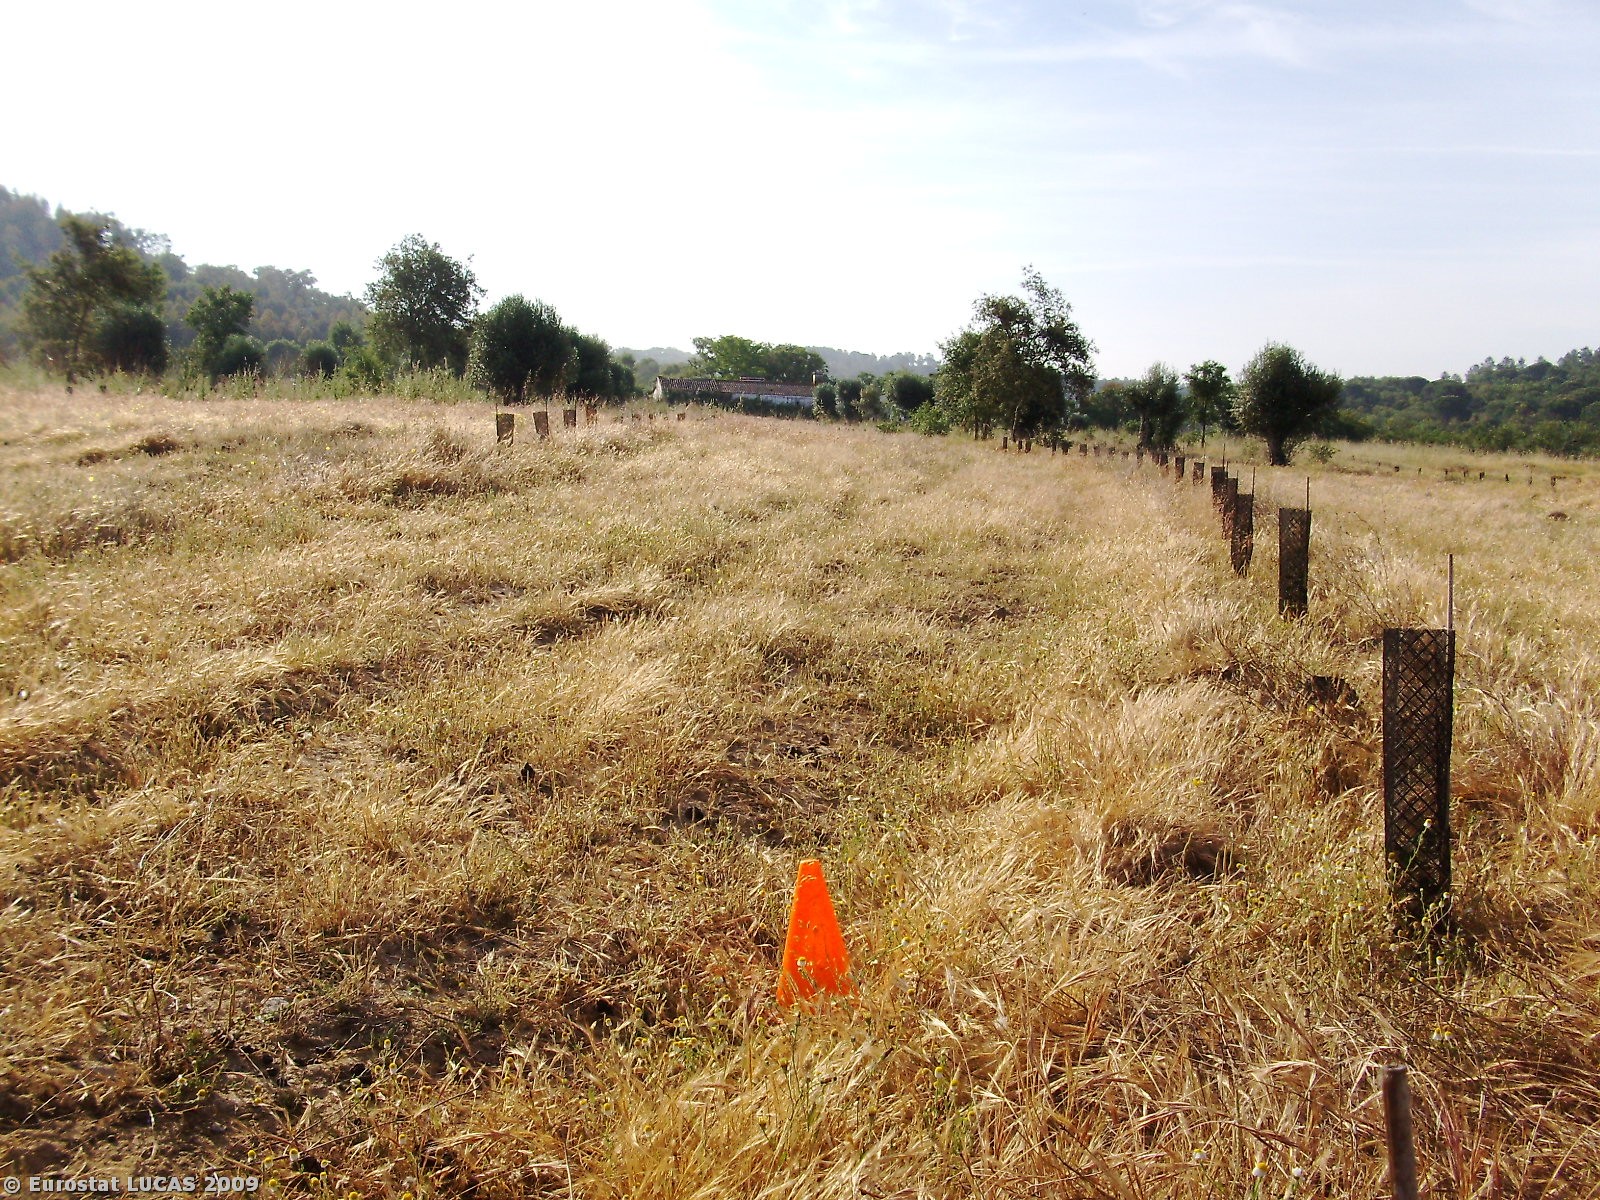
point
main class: Woodland
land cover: Broadleaved woodland
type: broadleaved evergreen forest
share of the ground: 10 - 25 %
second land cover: Grassland with sparse tree/shrub cover
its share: > 75 %
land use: Forestry
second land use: Agriculture (excluding fallow land and kitchen gardens)
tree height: > 5 m
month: May
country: PT
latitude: 39.0898
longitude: -8.0777
